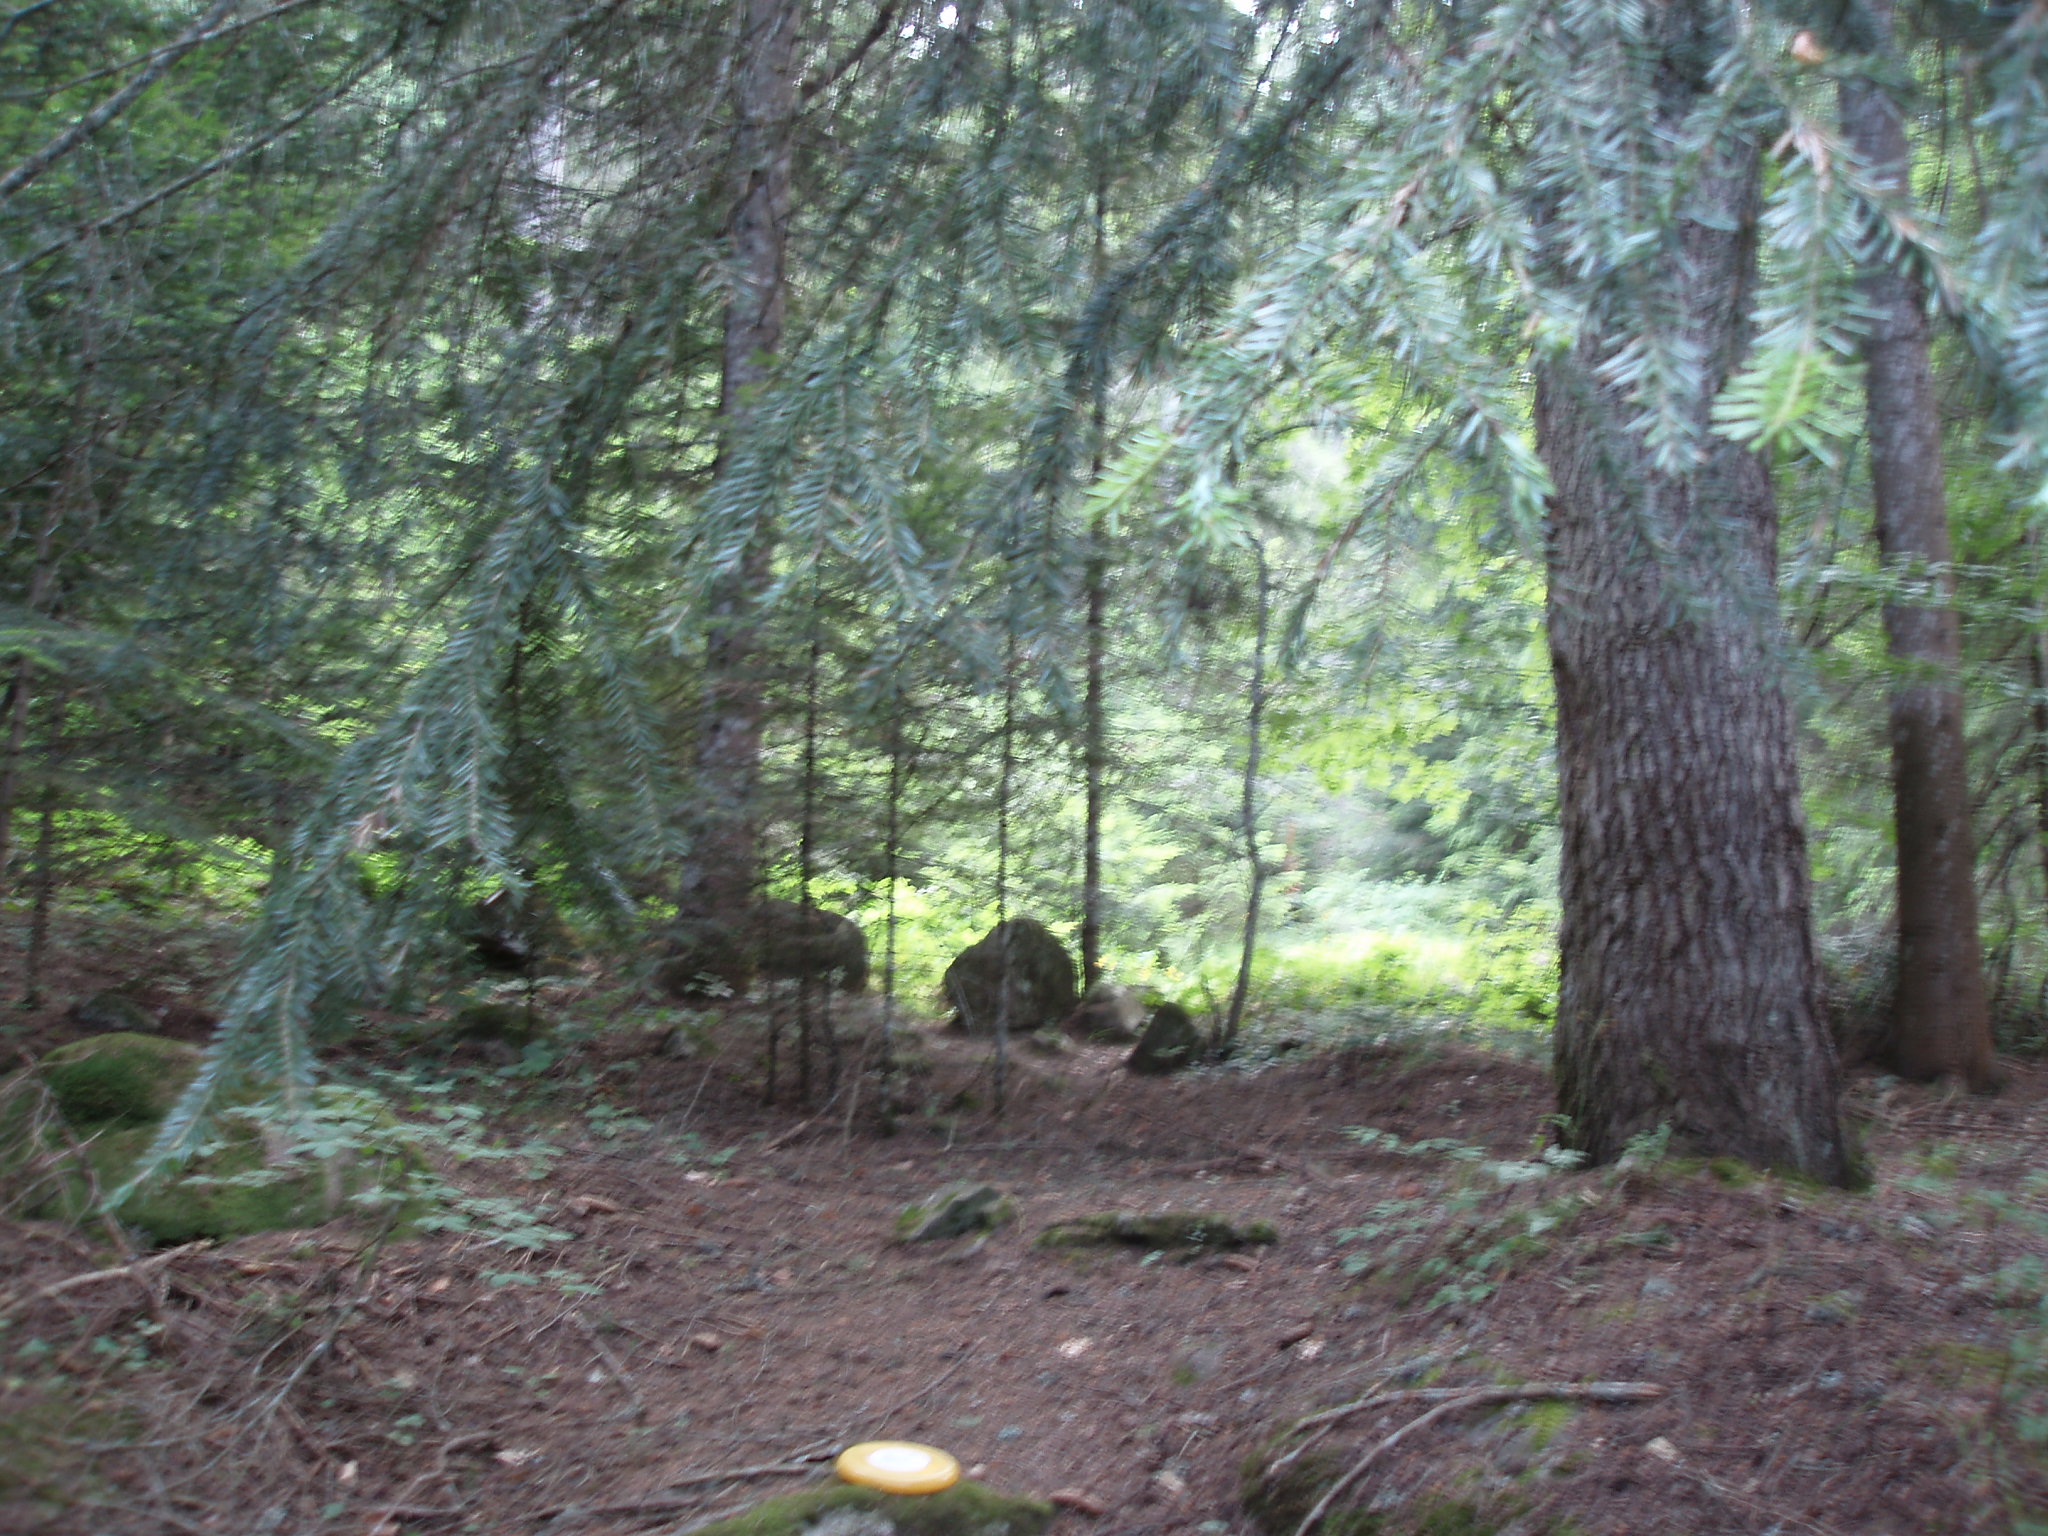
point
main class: Woodland
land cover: Spruce dominated mixed woodland
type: hemiboreal forest and nemoral coniferous forest and mixed broadleaved-coniferous forest
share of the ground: > 75 %
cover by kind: coniferous forest trees 75 %, broadleaved forest trees 25 %
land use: Amenities, museums, leisure
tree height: > 5 m
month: July
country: BG
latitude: 41.8043
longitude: 23.4713
